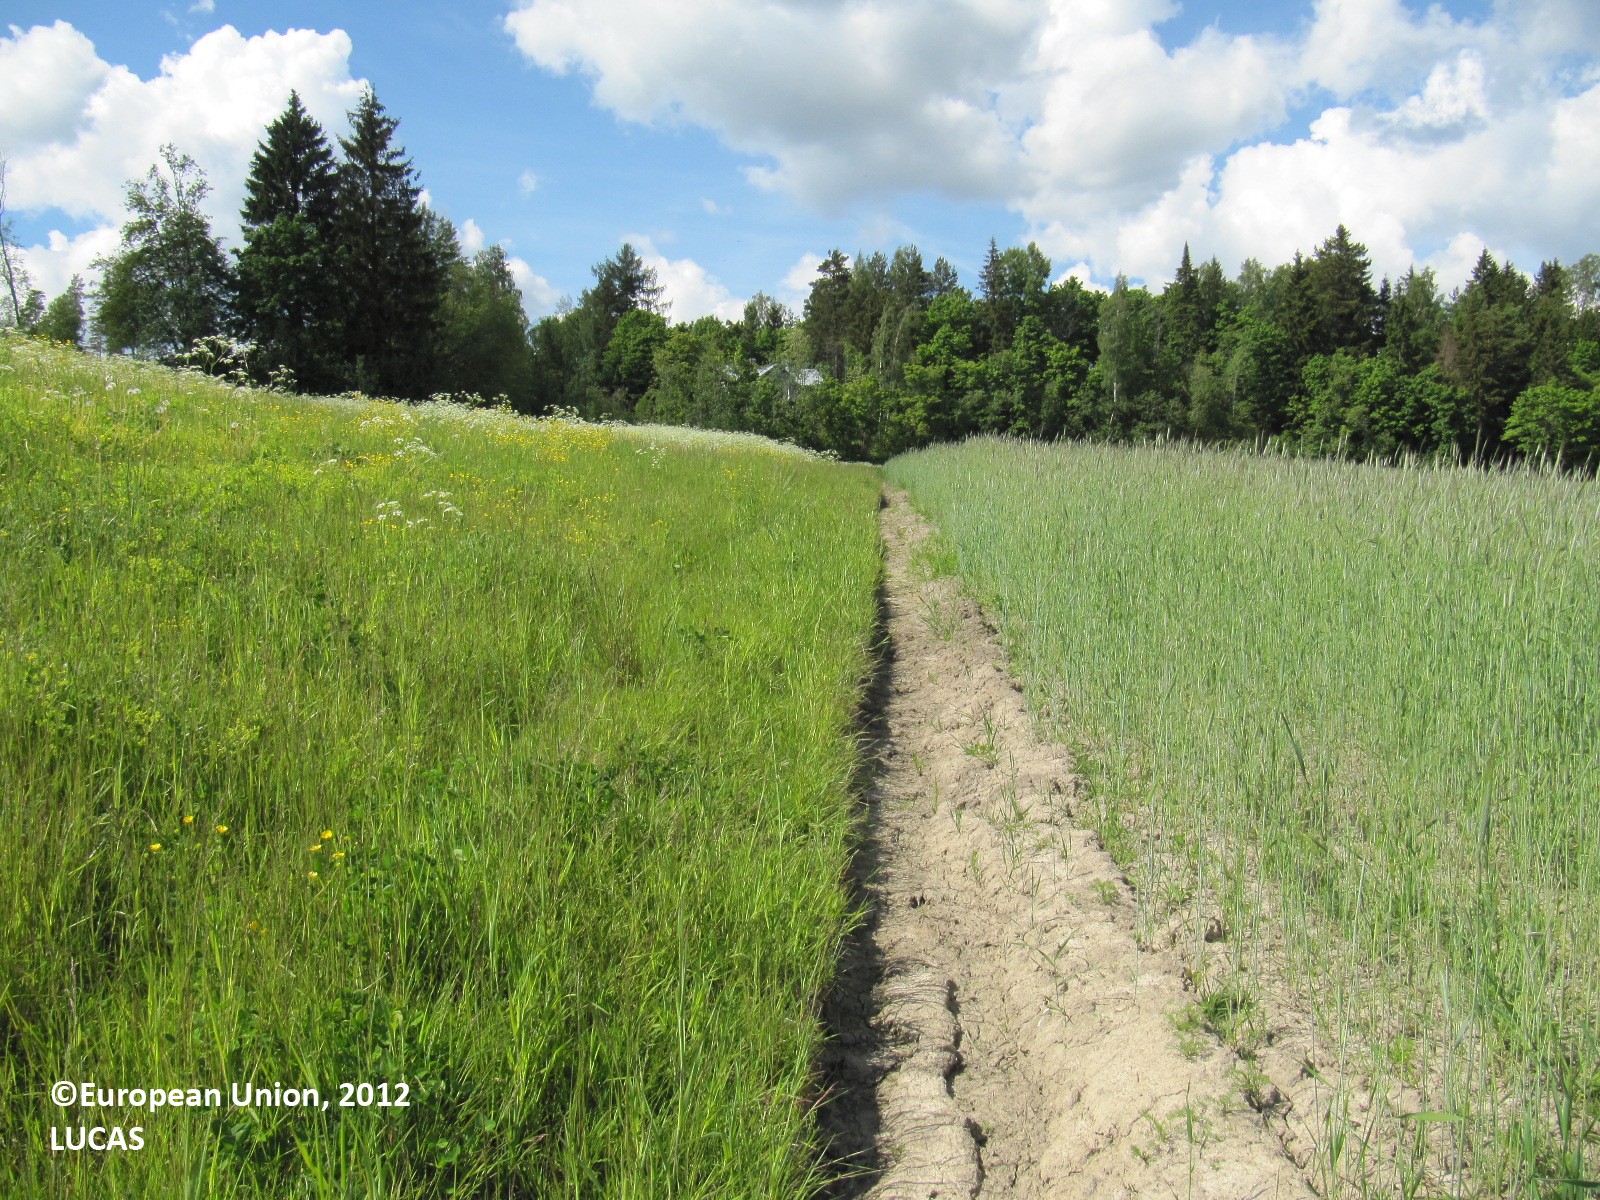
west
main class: Cropland
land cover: Rye
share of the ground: > 75 %
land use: Agriculture (excluding fallow land and kitchen gardens)
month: June
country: FI
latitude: 60.2941
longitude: 23.8990
